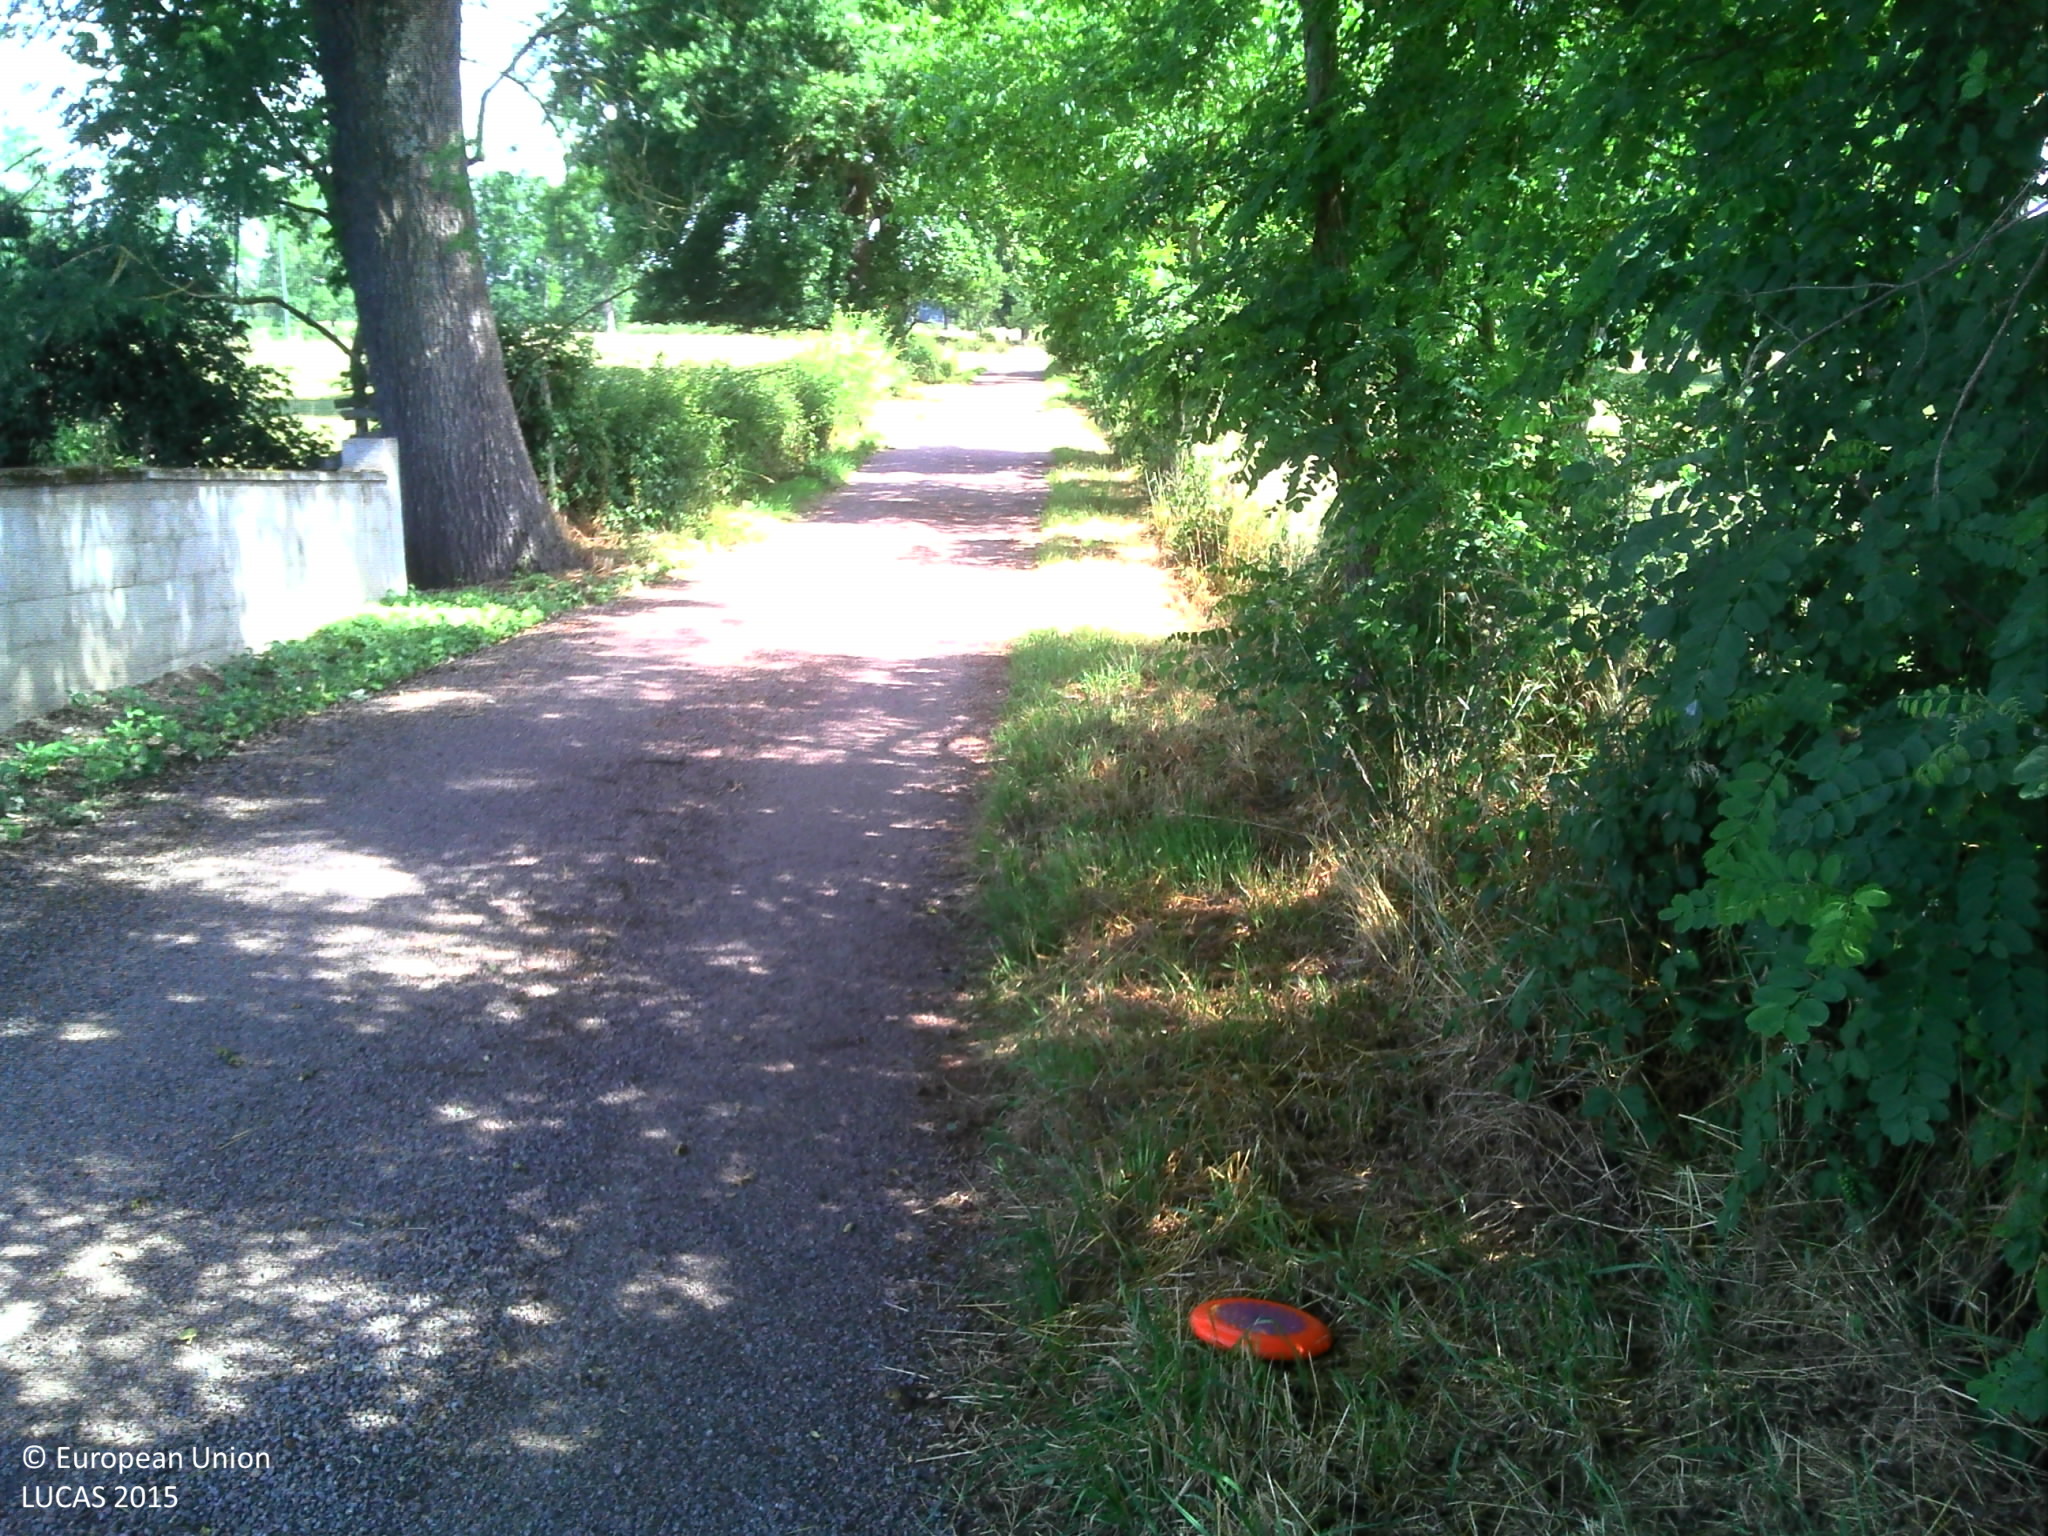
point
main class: Grassland
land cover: Grassland without tree/shrub cover
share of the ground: > 75 %
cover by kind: herbaceous plants 100 %
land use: Agriculture (excluding fallow land and kitchen gardens)
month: June
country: FR
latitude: 46.3638
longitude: 4.0086
